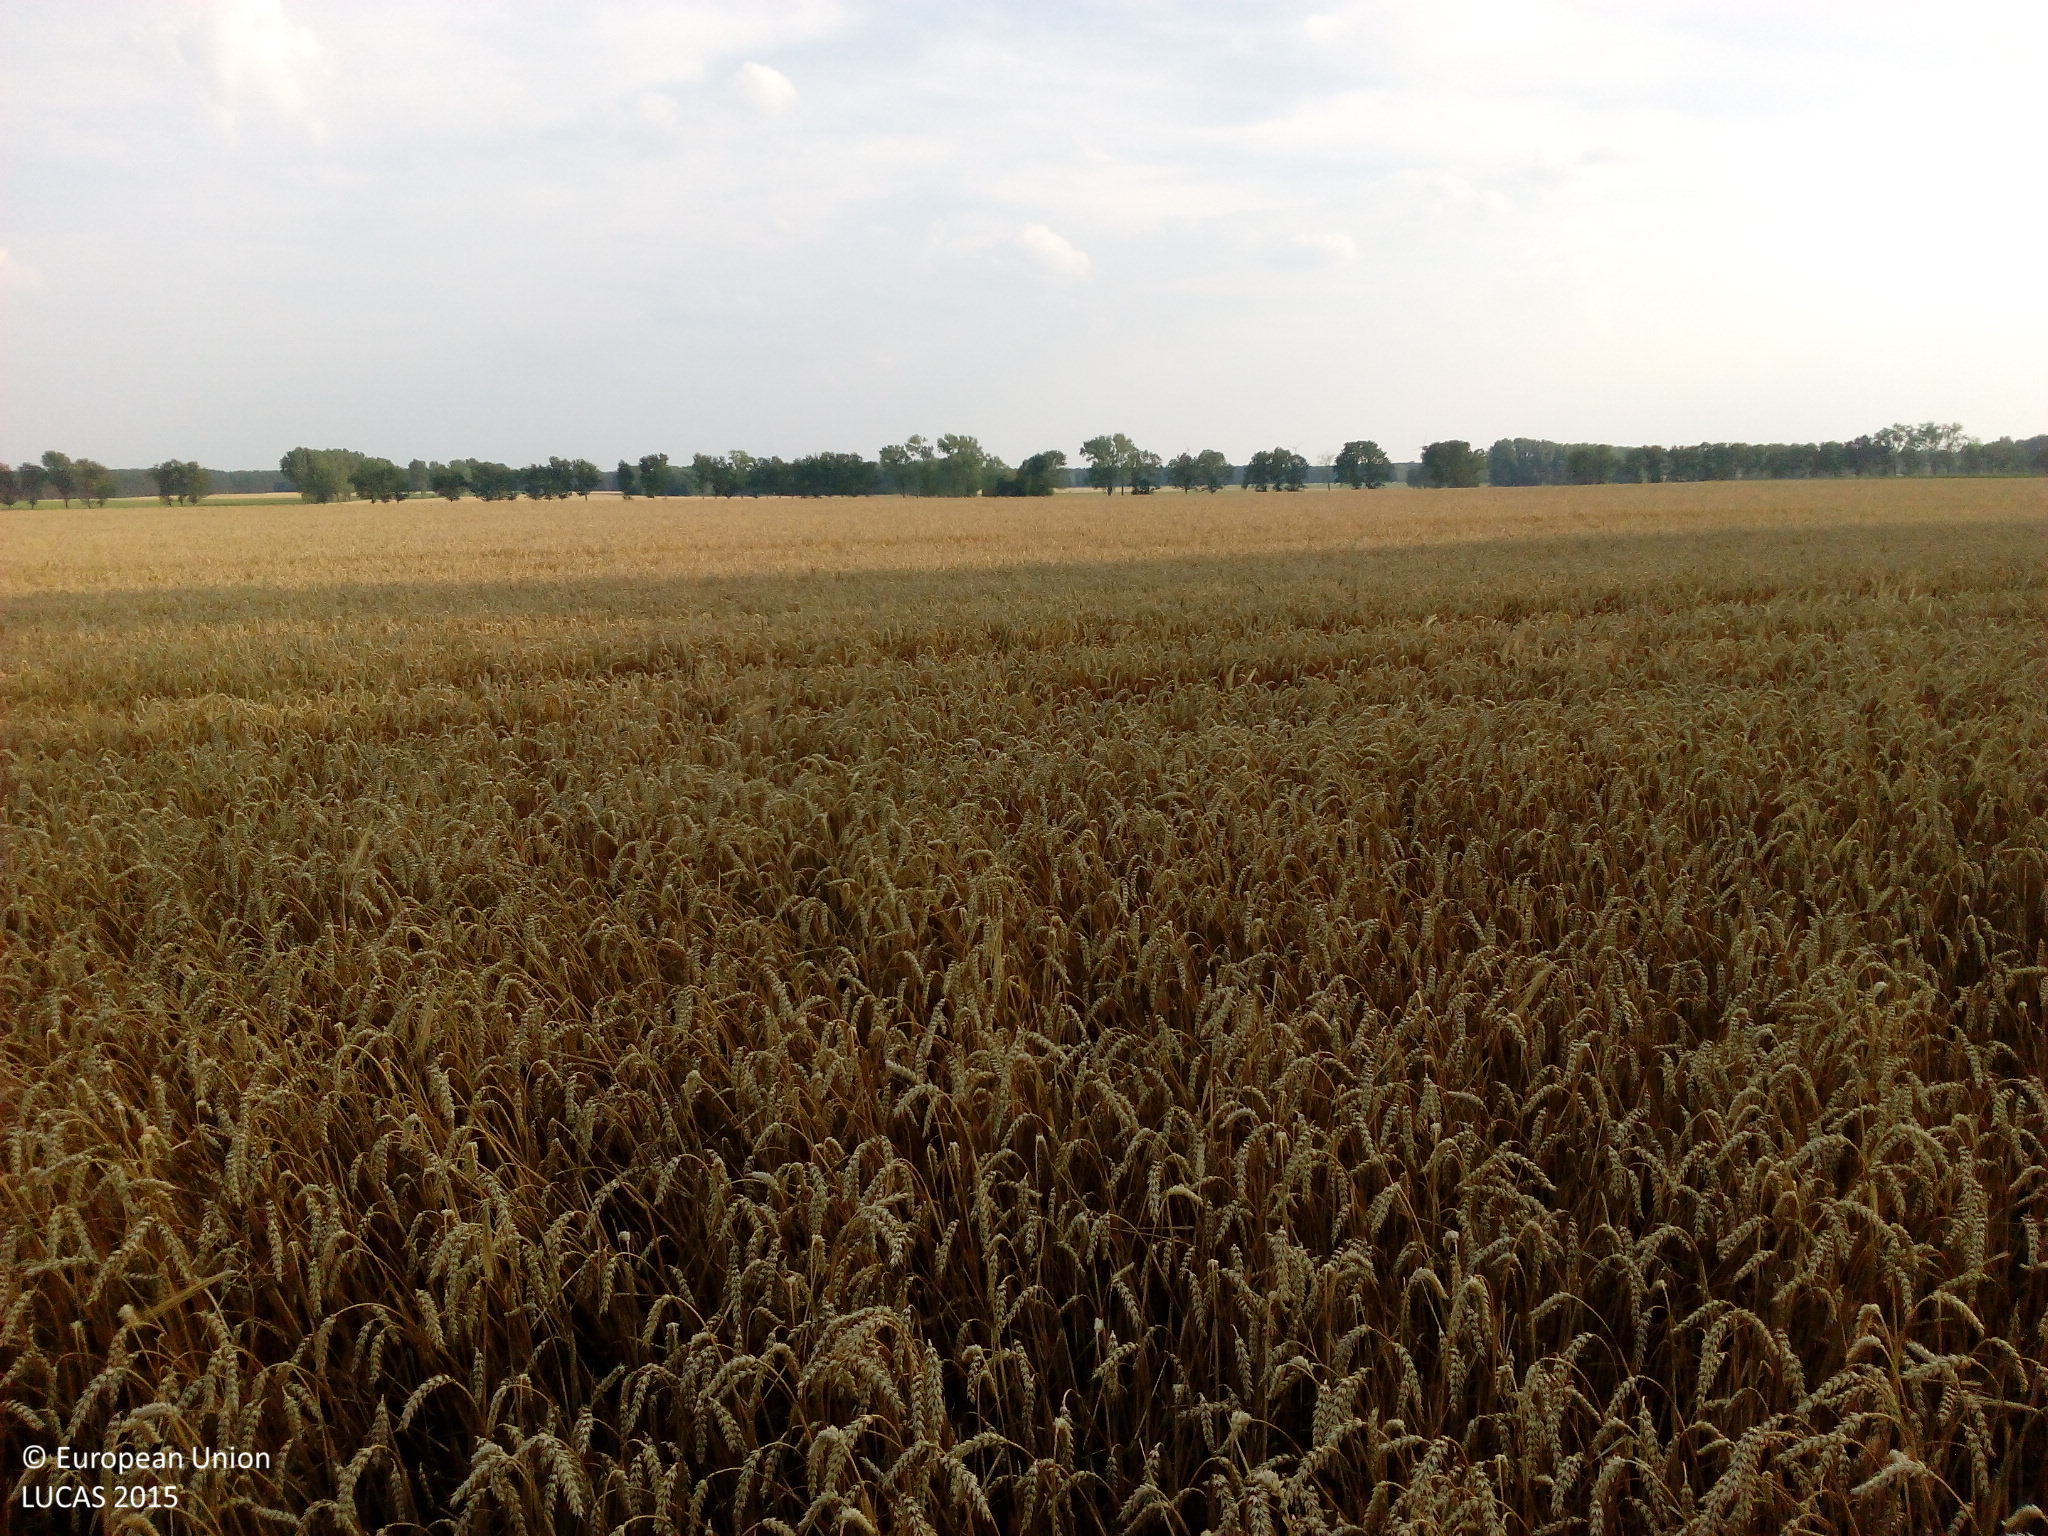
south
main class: Cropland
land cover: Common wheat
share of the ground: > 75 %
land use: Agriculture (excluding fallow land and kitchen gardens)
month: August
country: DE
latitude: 51.9039
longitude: 13.1541
